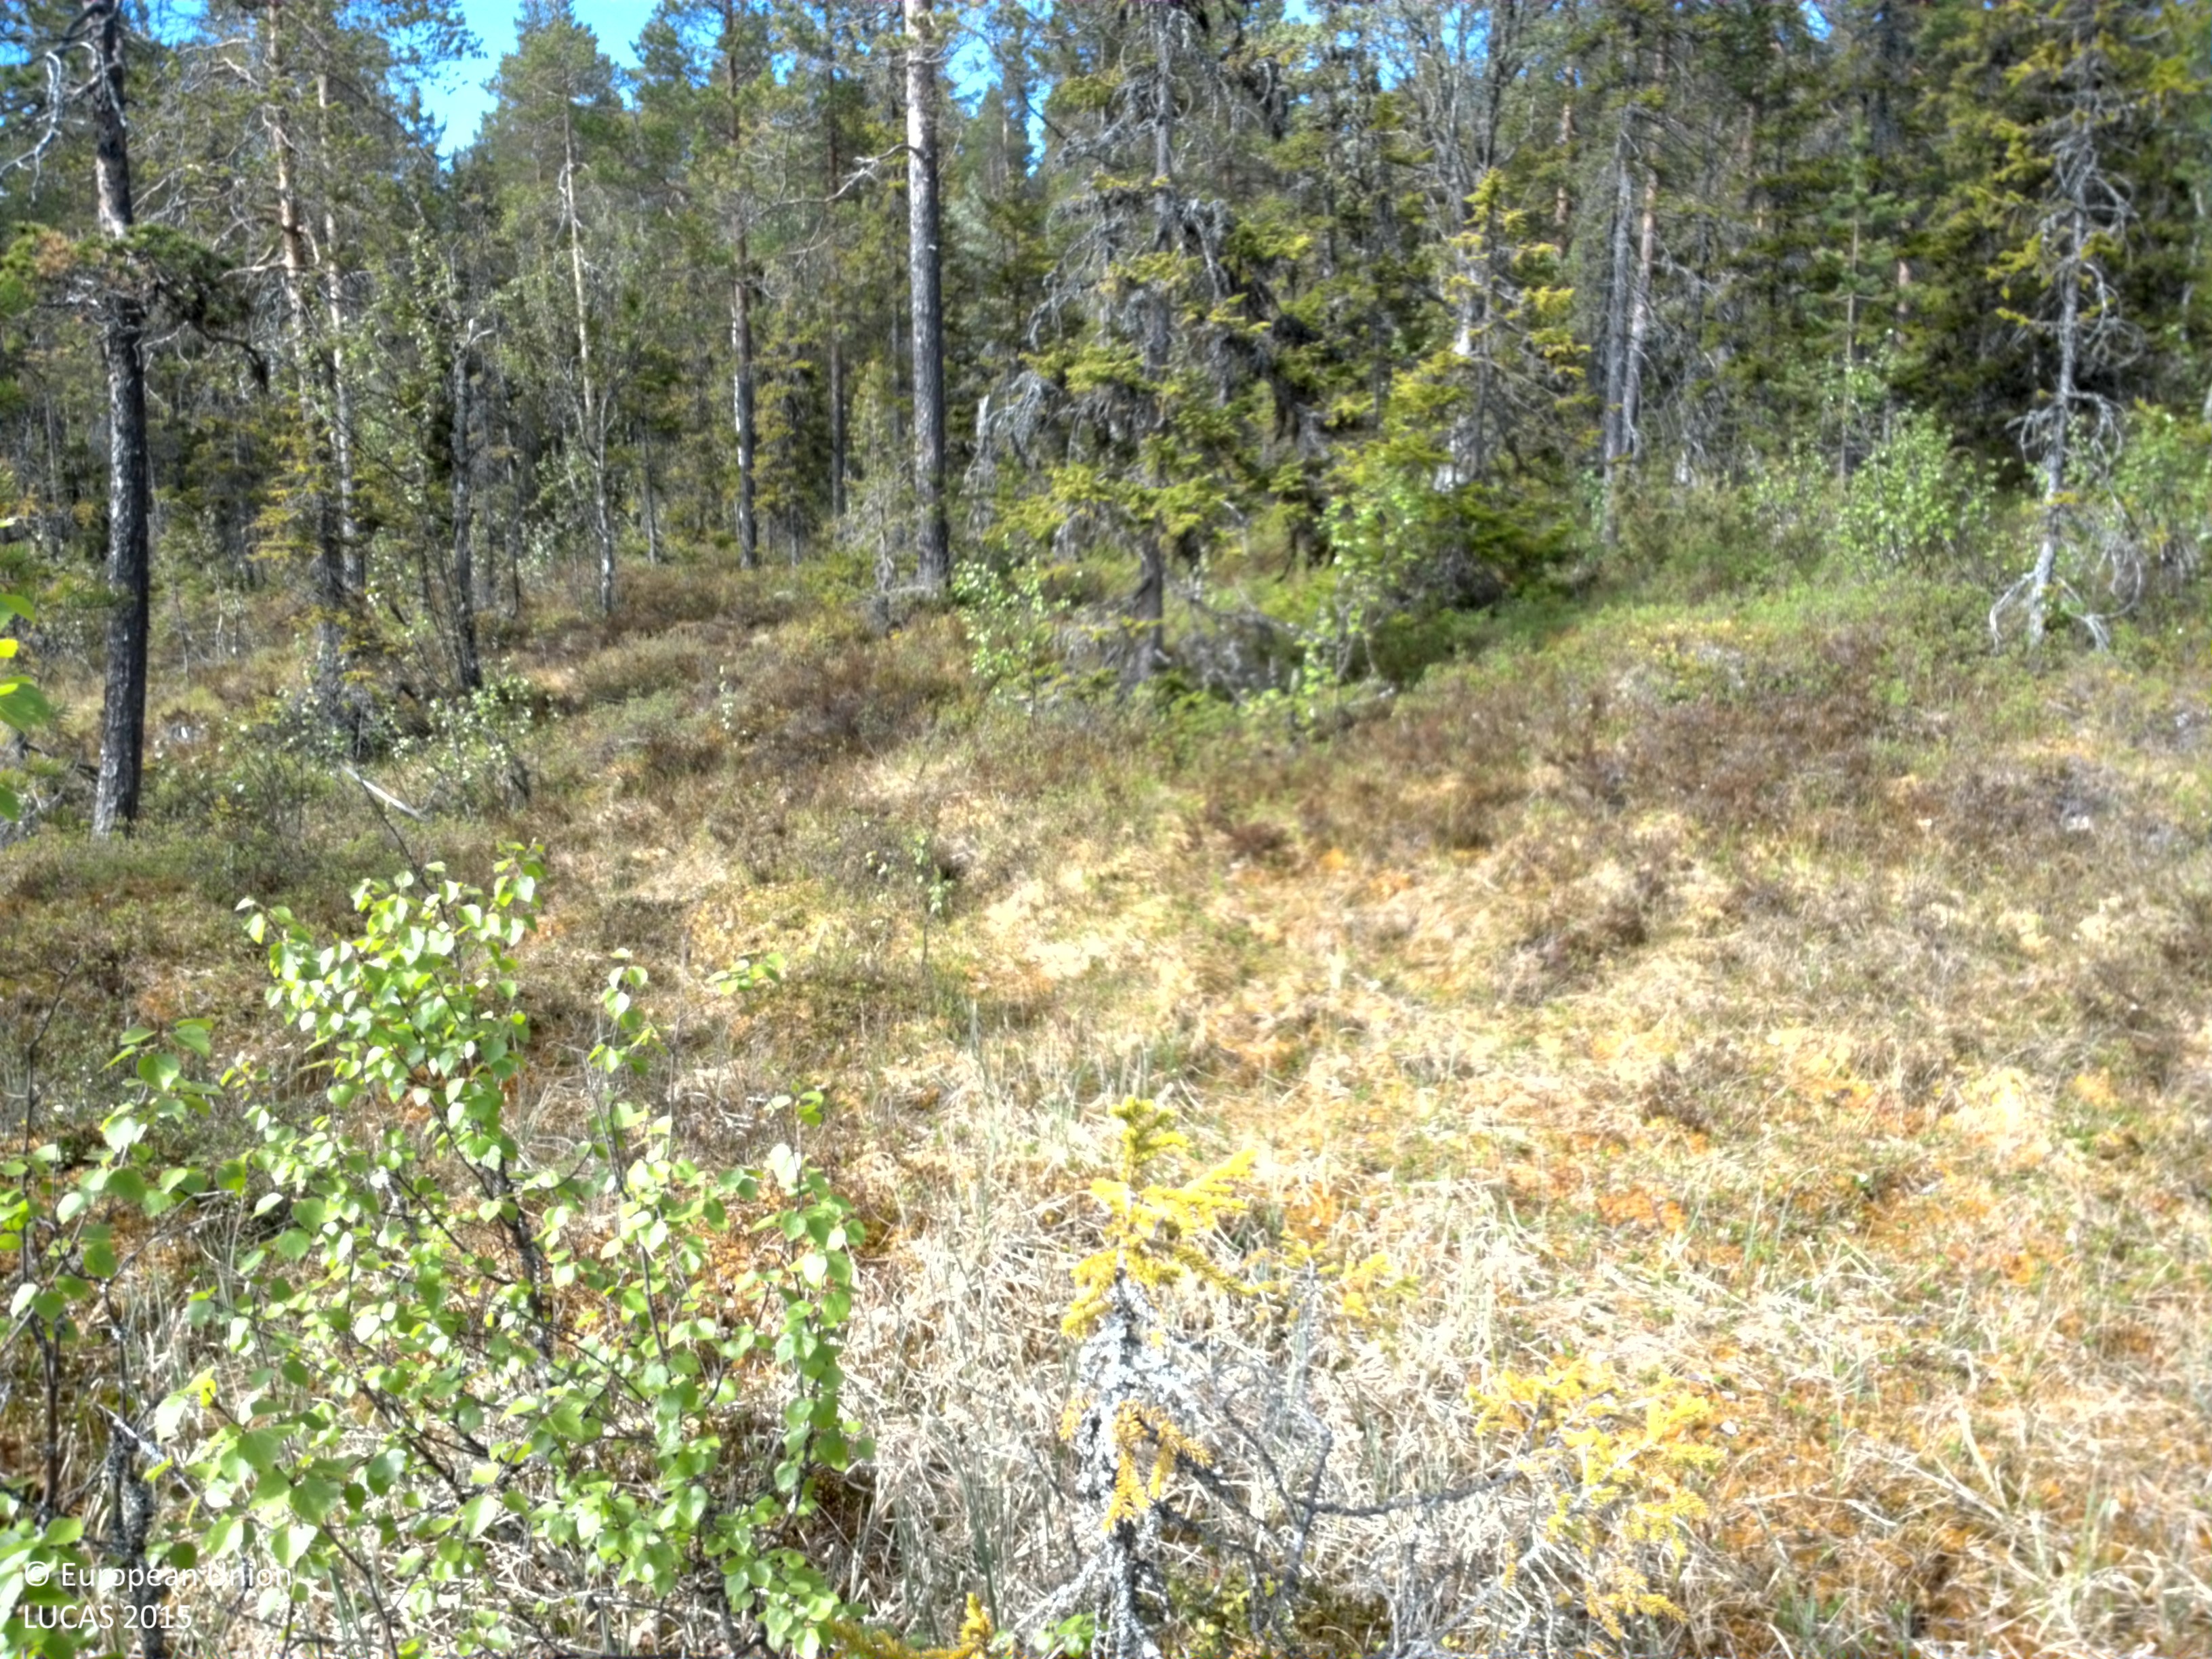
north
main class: Woodland
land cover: Pine dominated mixed woodland
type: boreal forest
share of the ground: 10 - 25 %
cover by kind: herbaceous plants 35 %, lichens and mosses 35 %, coniferous forest trees 15 %, broadleaved forest trees 10 %, shrubs 5 %
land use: Forestry
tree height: > 5 m
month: June
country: SE
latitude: 61.9352
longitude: 13.7010
